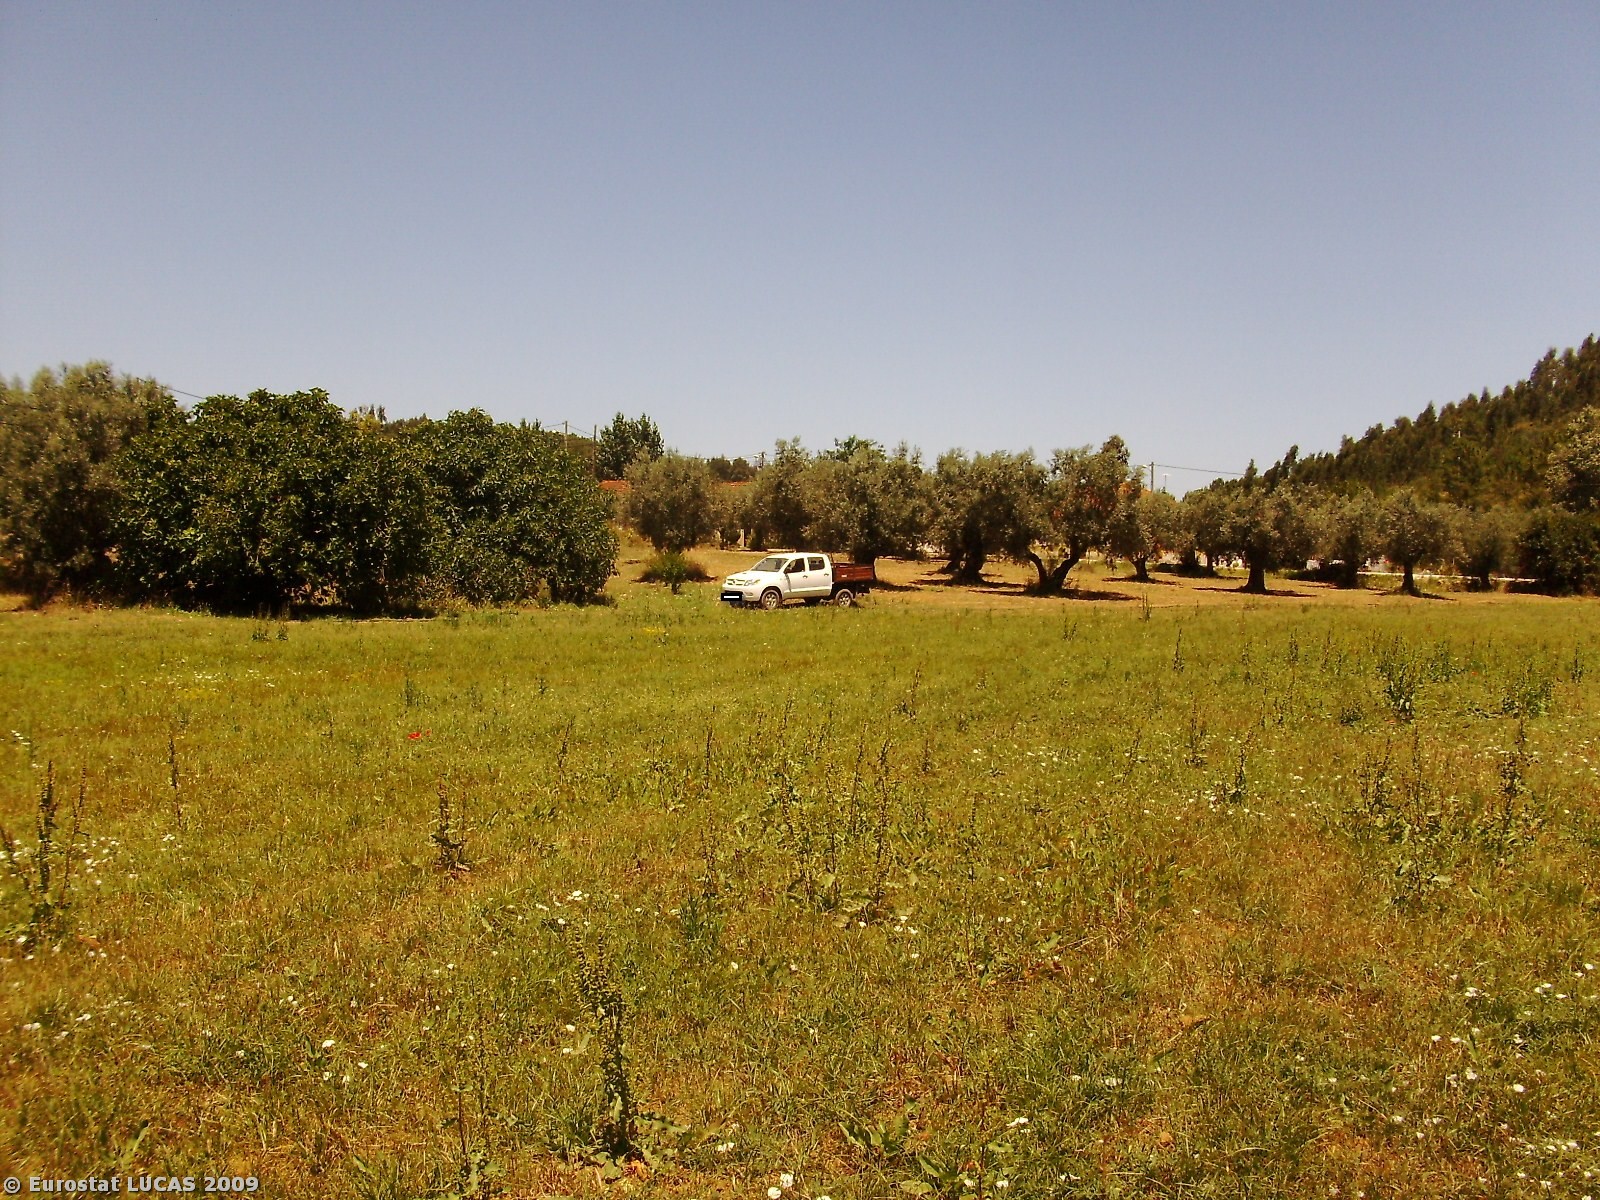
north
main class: Grassland
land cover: Grassland without tree/shrub cover
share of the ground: > 75 %
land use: Agriculture (excluding fallow land and kitchen gardens)
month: July
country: PT
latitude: 39.4012
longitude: -8.8582
